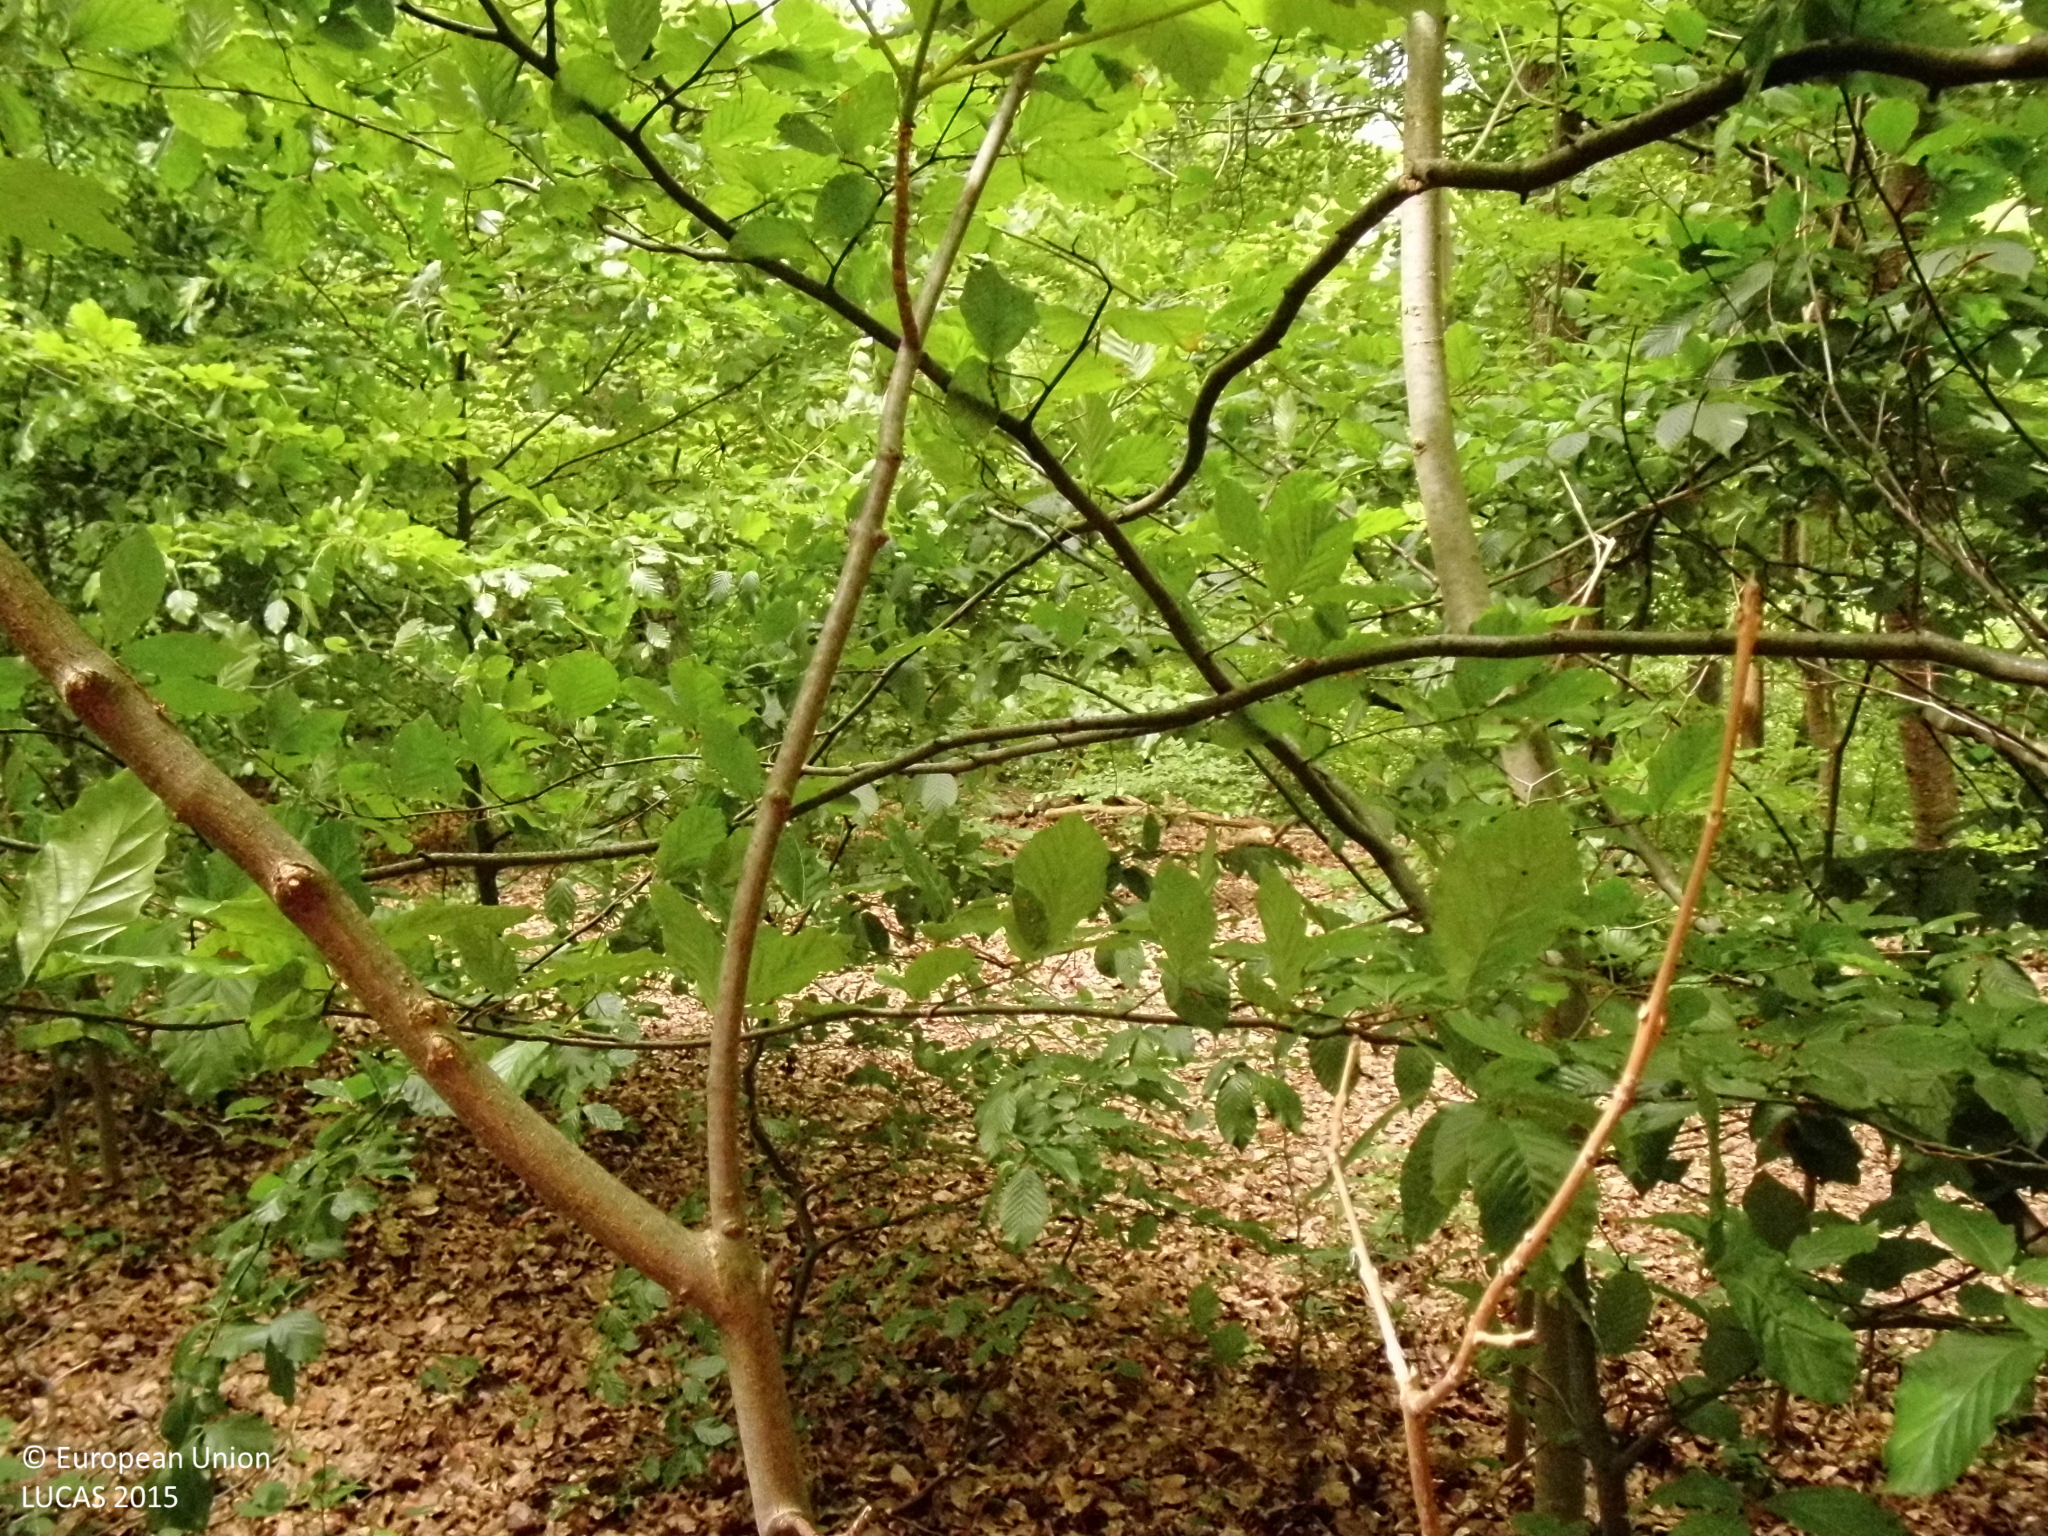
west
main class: Woodland
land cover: Broadleaved woodland
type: mesophytic deciduous forest
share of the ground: > 75 %
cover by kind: broadleaved forest trees 95 %, unconsolidated bare surface 5 %
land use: Forestry
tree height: > 5 m
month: May
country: DE
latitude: 51.3426
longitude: 7.4305
